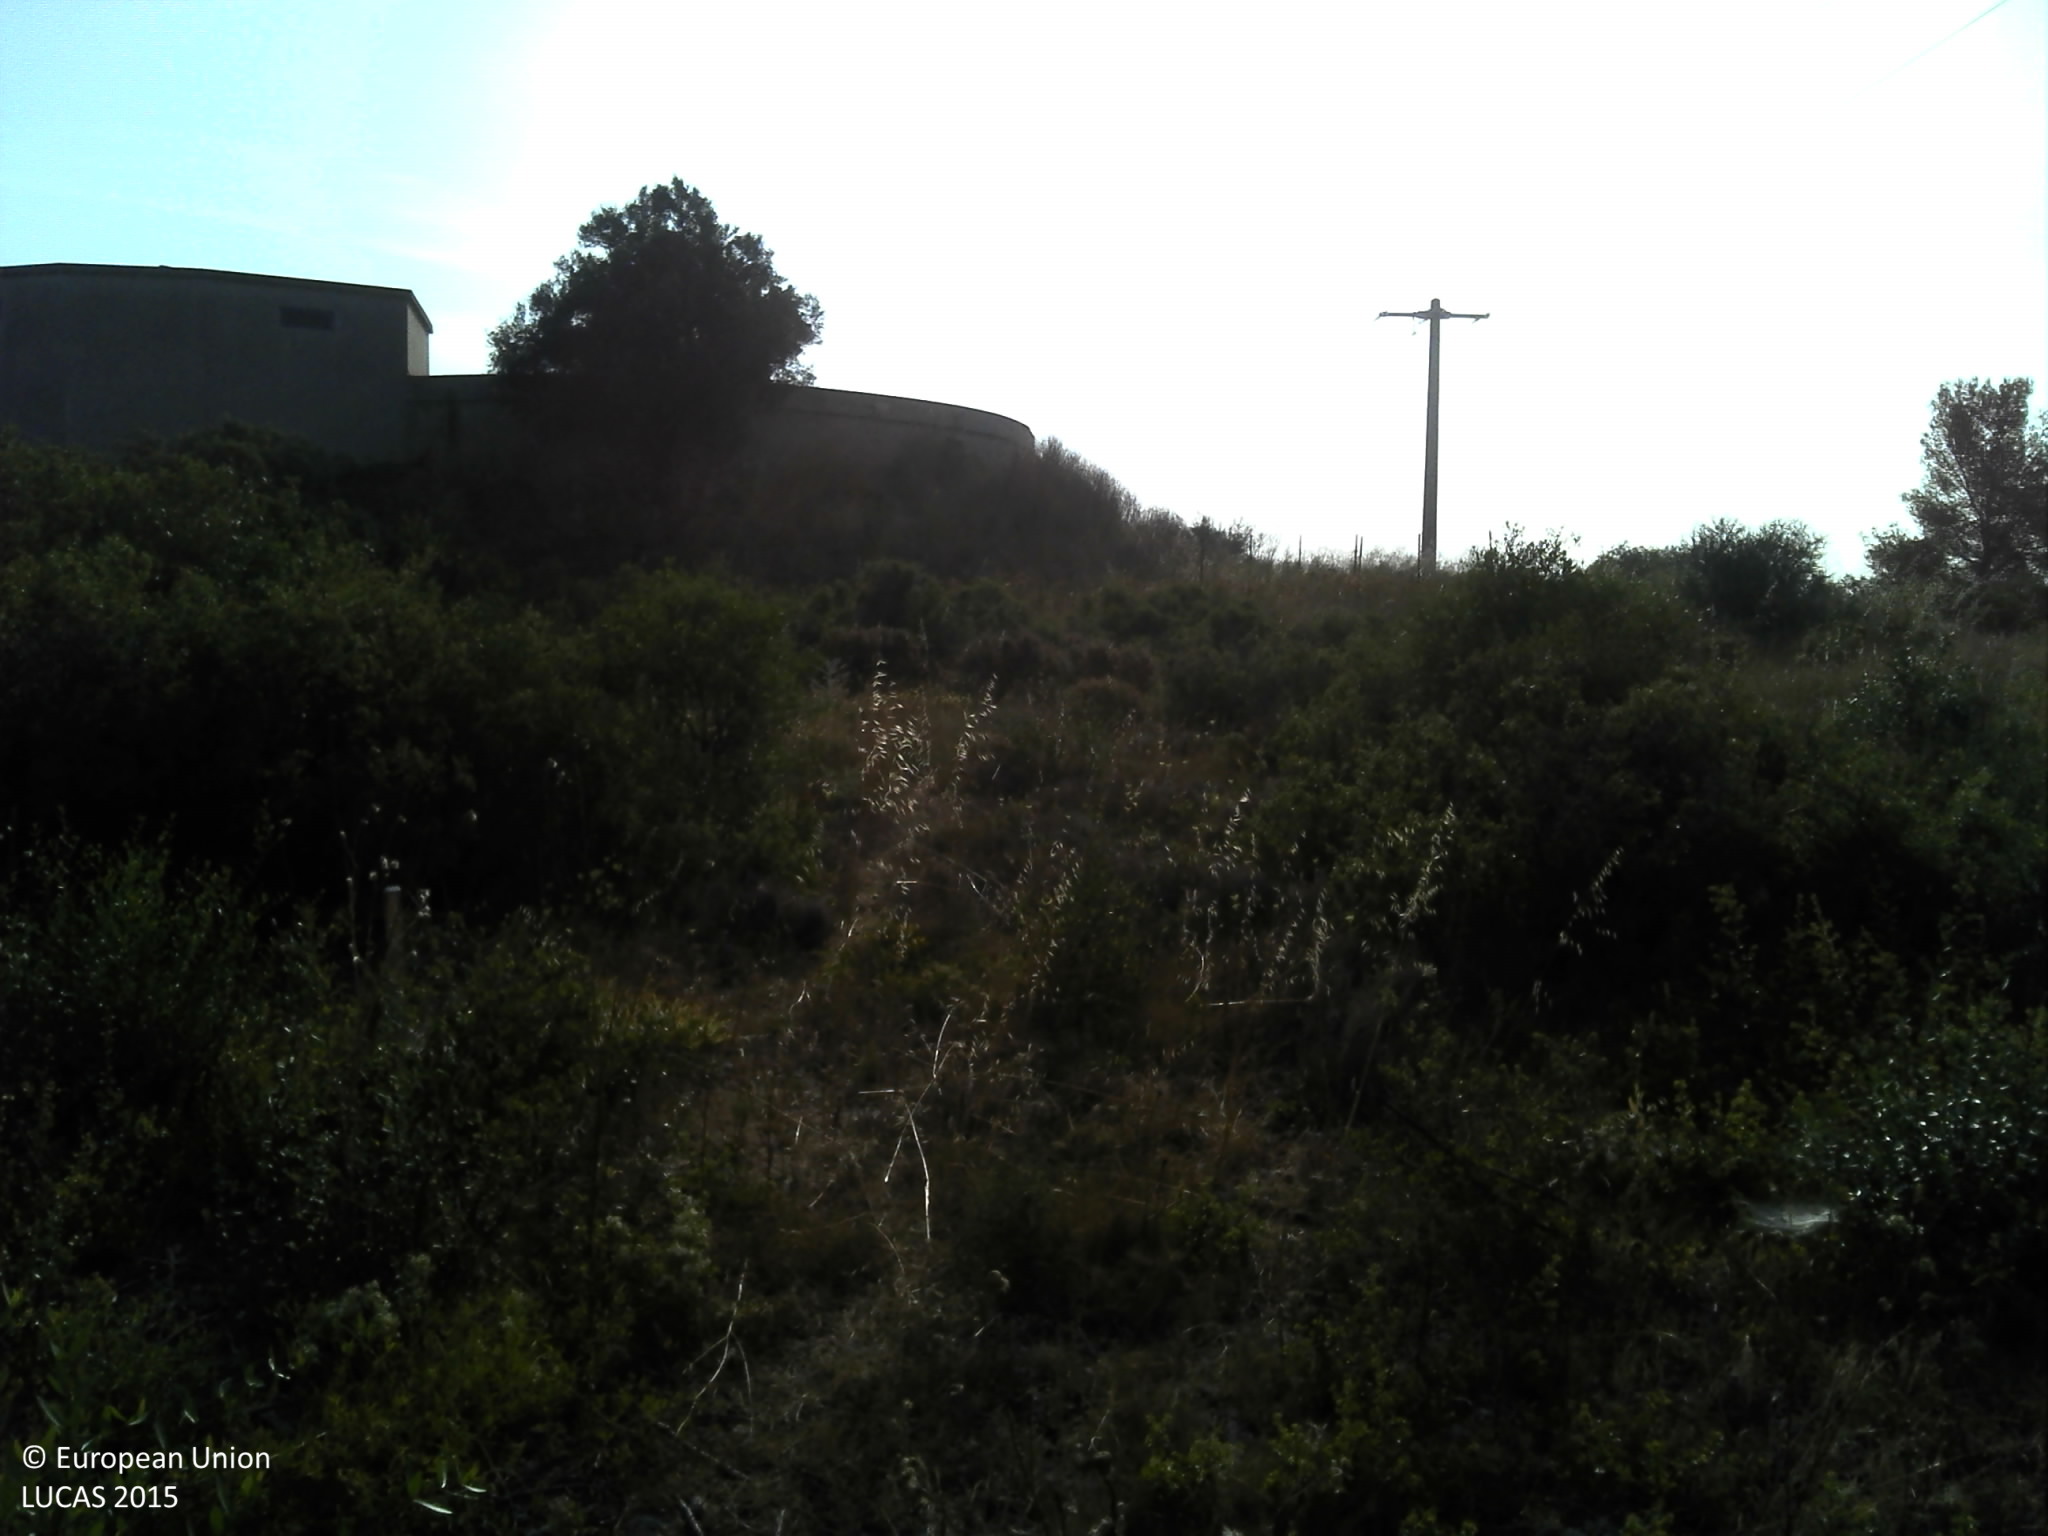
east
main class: Shrubland
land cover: Shrubland with sparse tree cover
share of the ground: > 75 %
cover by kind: shrubs 65 %, herbaceous plants 10 %, consolidated bare surface 10 %, unconsolidated bare surface 10 %, broadleaved forest trees 5 %
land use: Semi-natural and natural areas not in use
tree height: < 5 m
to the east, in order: Shrubland with sparse tree cover; Spontaneously vegetated surfaces; Fences; Spontaneously vegetated surfaces; Fences; Shrubland with sparse tree cover; Electric lines; Tracks; Shrubland with sparse tree cover; Pine dominated mixed woodland; Fences; Grassland without tree/shrub cover
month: July
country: FR
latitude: 43.6702
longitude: 3.9939
